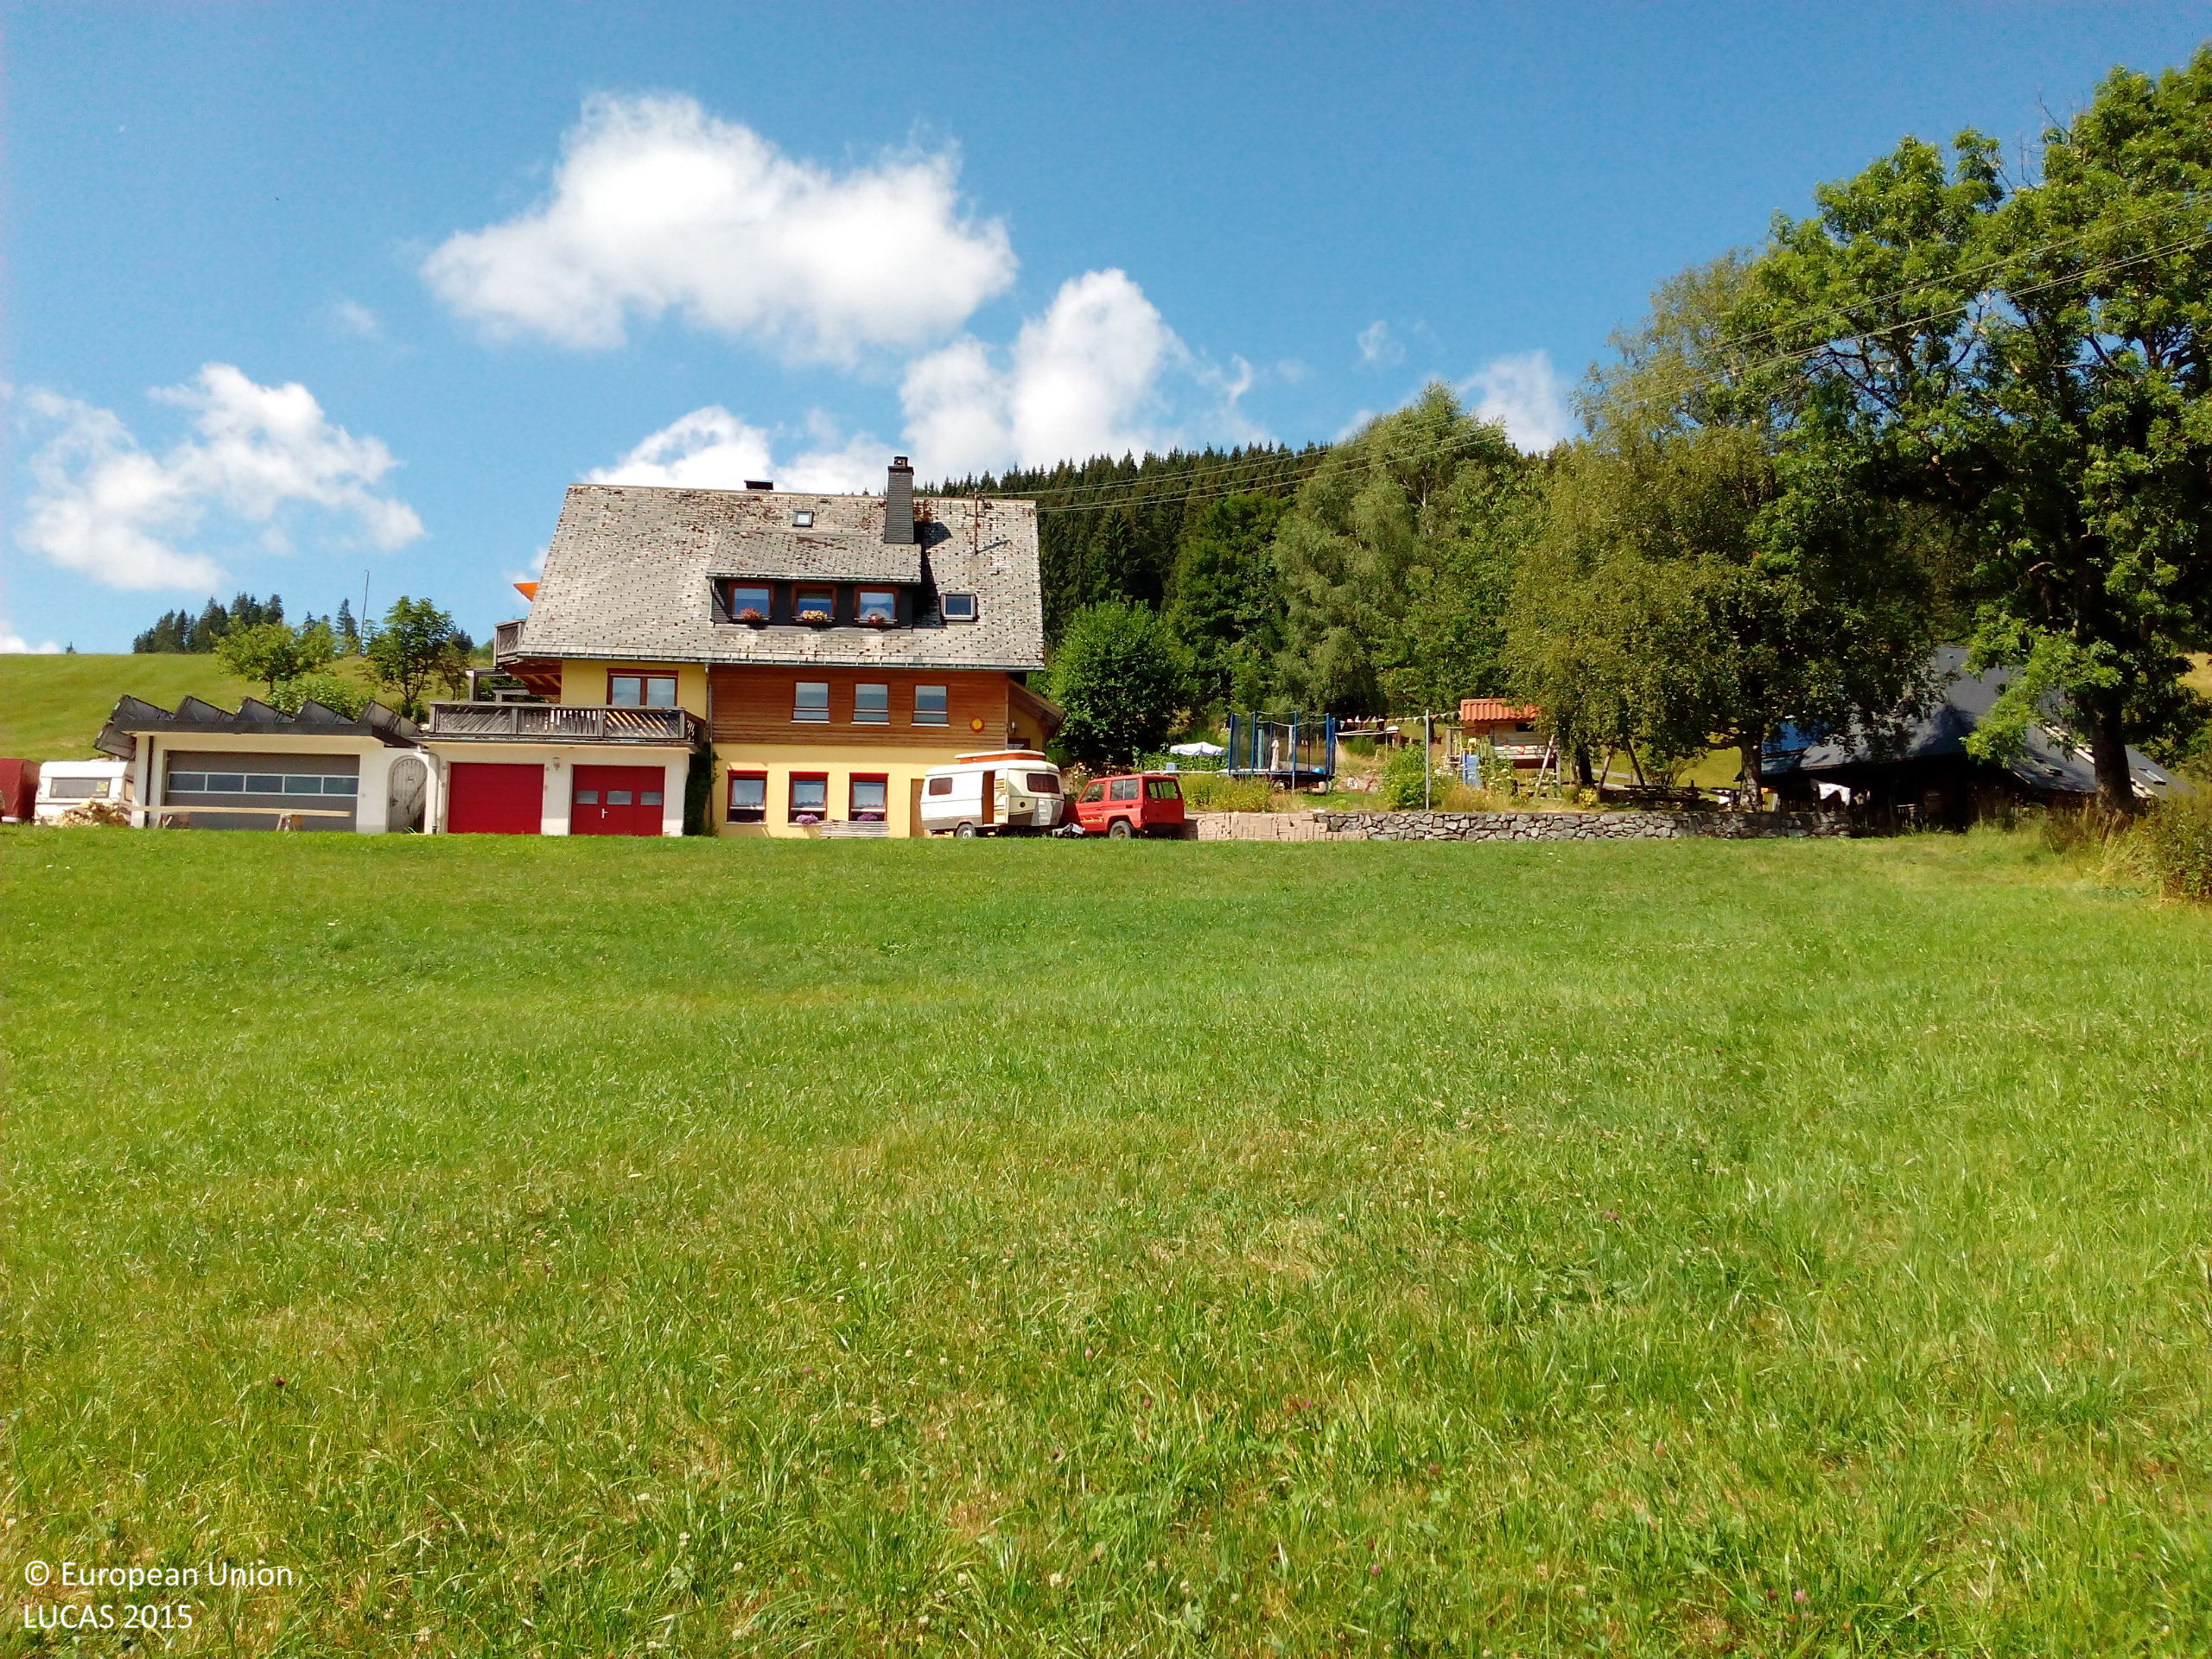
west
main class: Grassland
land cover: Grassland without tree/shrub cover
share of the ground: > 75 %
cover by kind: herbaceous plants 100 %
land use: Agriculture (excluding fallow land and kitchen gardens)
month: August
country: DE
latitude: 47.9387
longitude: 8.1939
